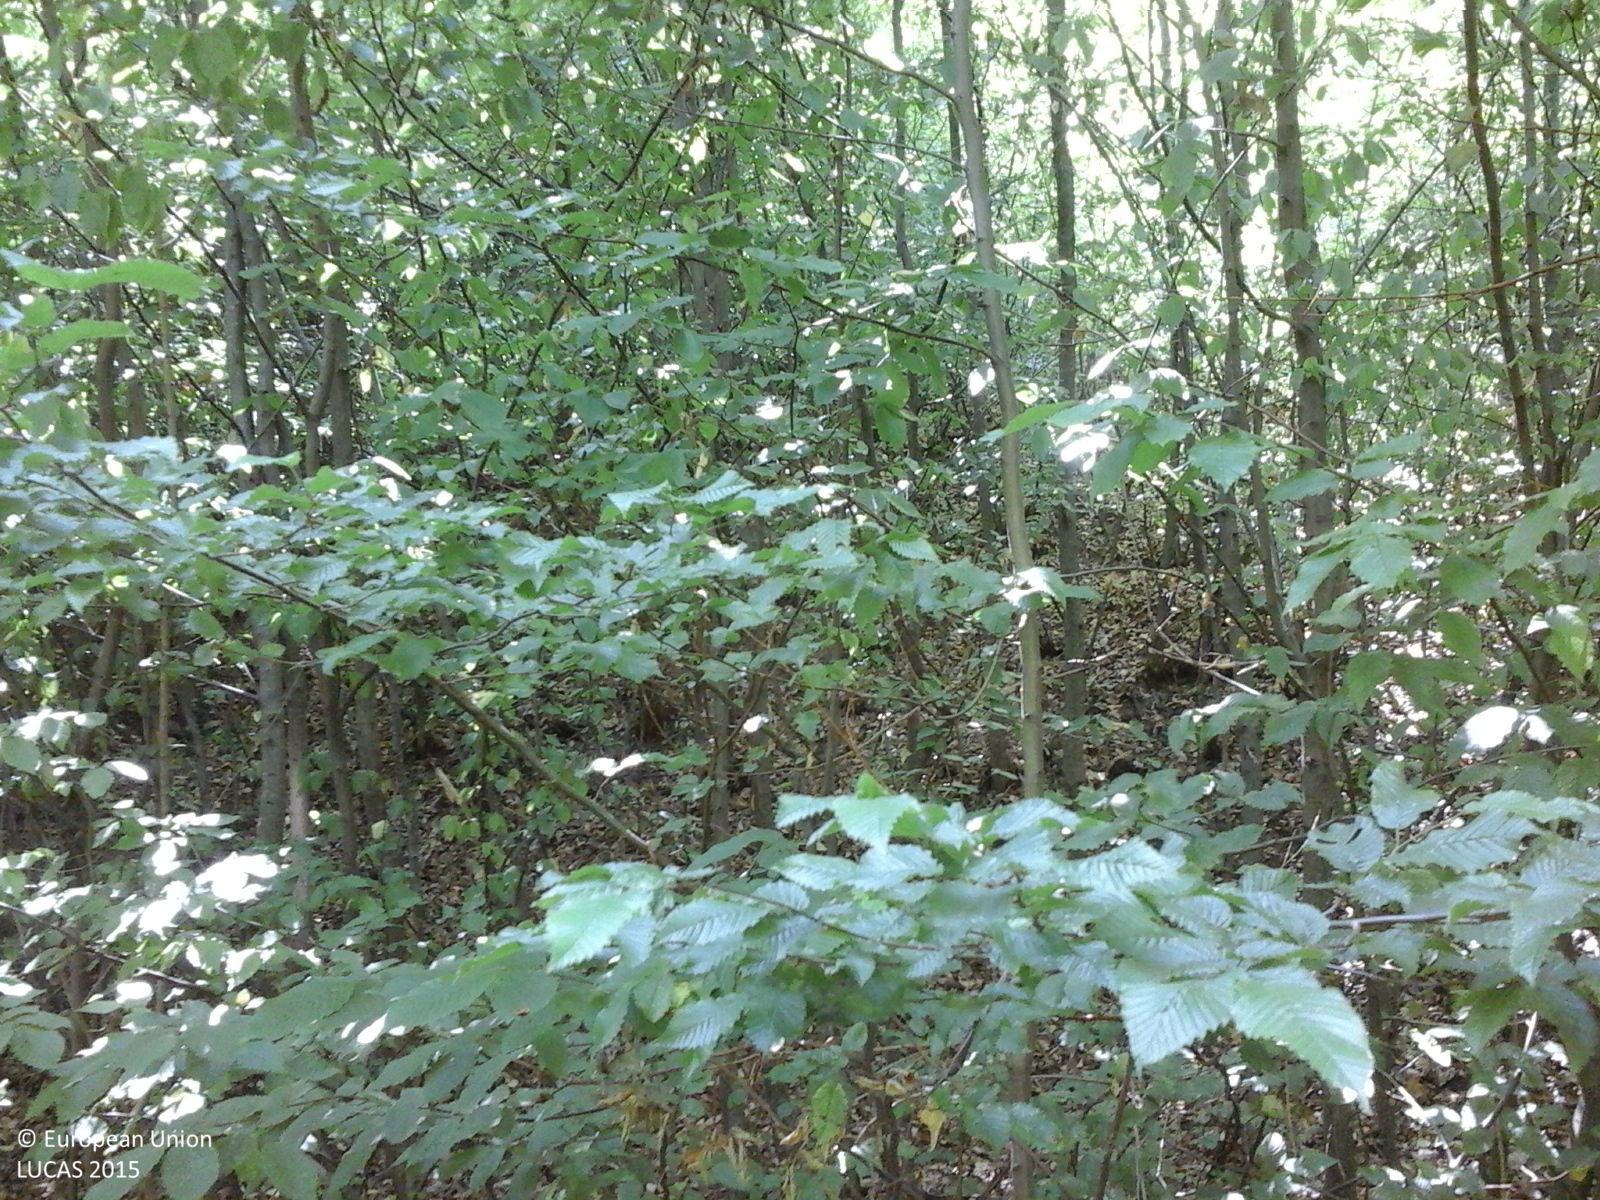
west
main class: Woodland
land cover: Broadleaved woodland
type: acidophilous oak and oak-birch forest
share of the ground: > 75 %
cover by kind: broadleaved forest trees 100 %
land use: Forestry
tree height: > 5 m
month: July
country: RO
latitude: 44.9066
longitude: 24.4487
